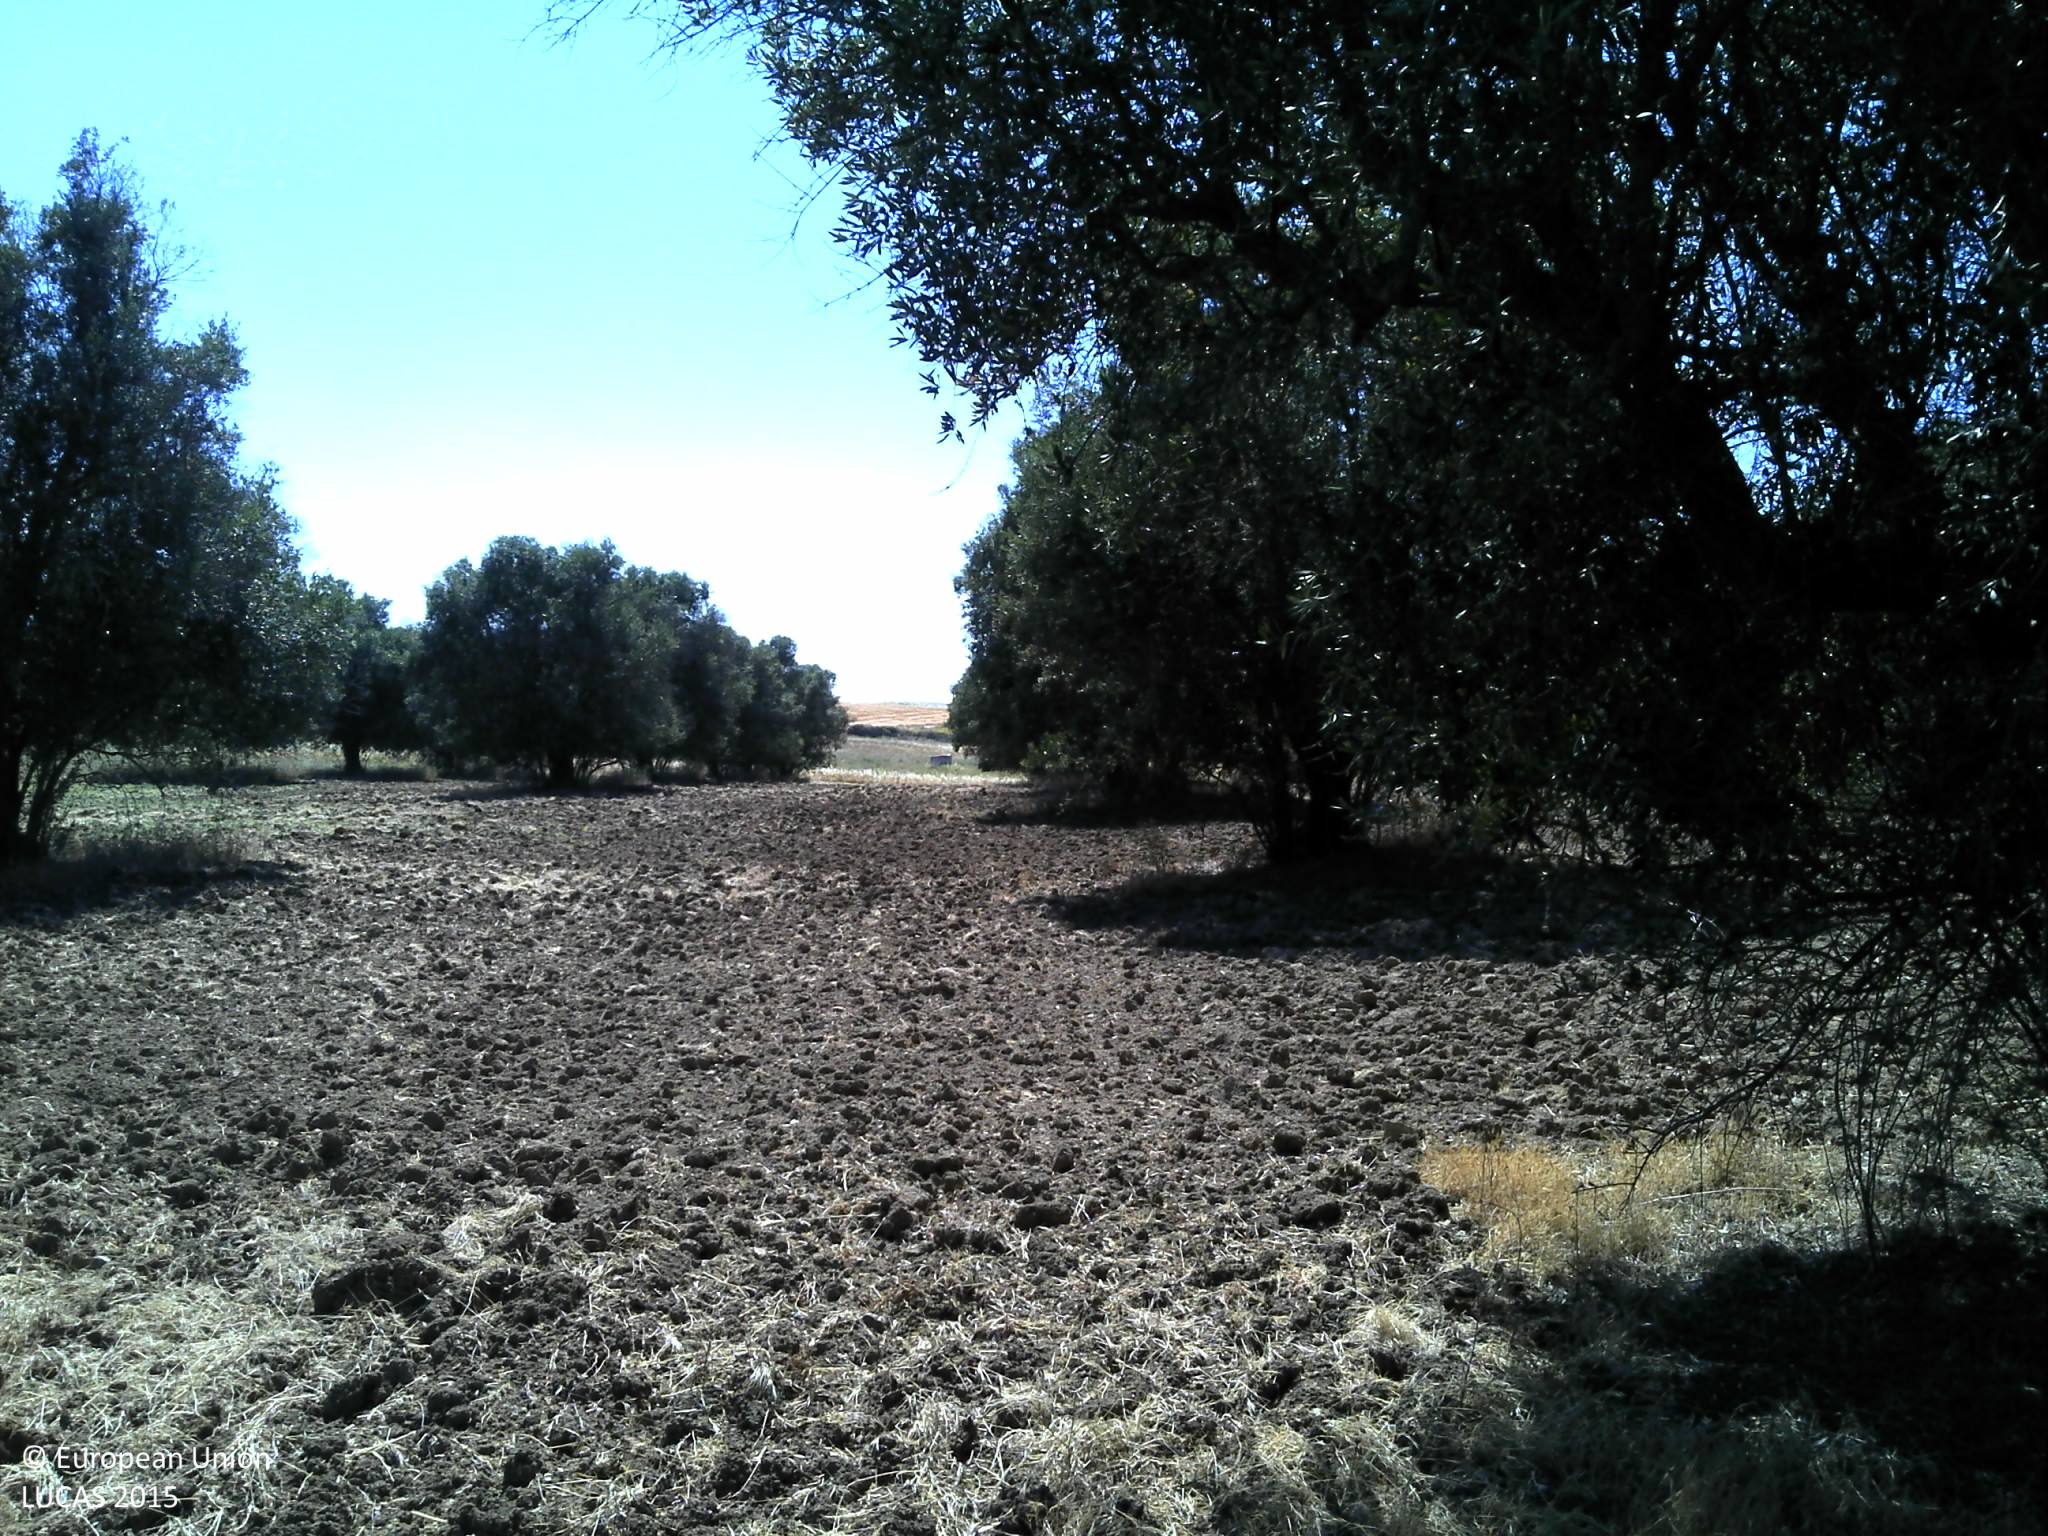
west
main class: Cropland
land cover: Olive groves
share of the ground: 25 - 50 %
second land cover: Other bare soil
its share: > 75 %
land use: Agriculture (excluding fallow land and kitchen gardens)
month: June
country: PT
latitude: 38.0944
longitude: -8.0615
